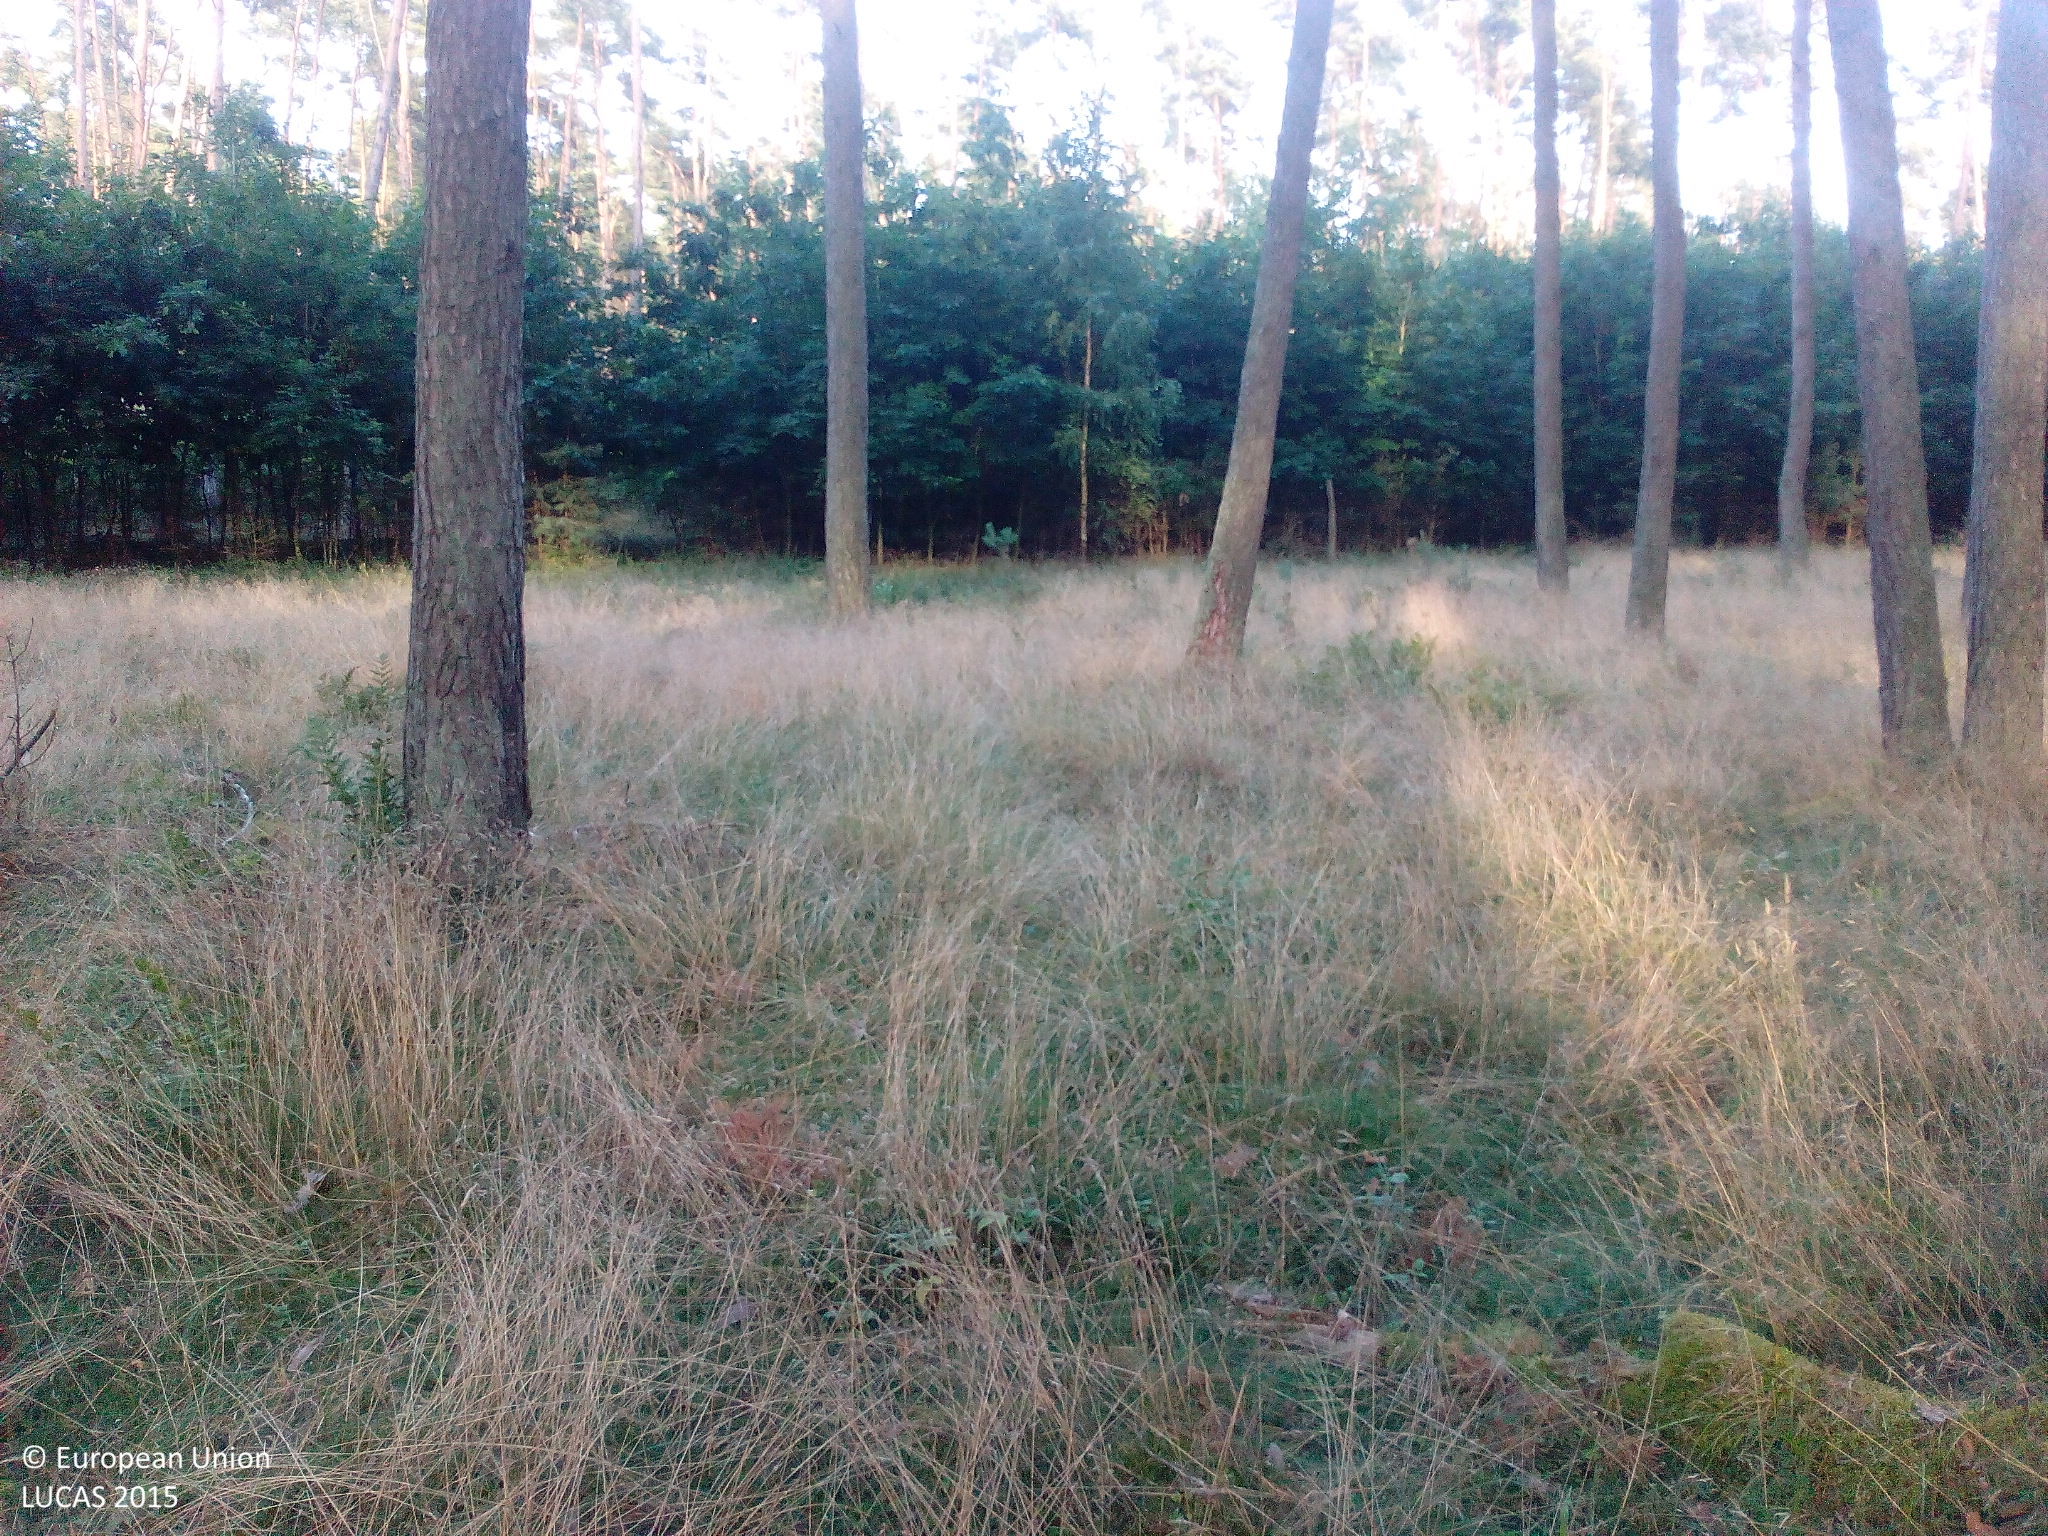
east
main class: Woodland
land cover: Pine dominated coniferous woodland
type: hemiboreal forest and nemoral coniferous forest and mixed broadleaved-coniferous forest
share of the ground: > 75 %
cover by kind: coniferous forest trees 75 %, herbaceous plants 25 %
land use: Forestry
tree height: > 5 m
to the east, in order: Pine dominated coniferous woodland; Tracks; Broadleaved woodland; Pine dominated mixed woodland; Tracks; Pine dominated mixed woodland; Grass margins; Paved roads, cycling and walking lanes; Grass margins; Pine dominated mixed woodland
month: August
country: DE
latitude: 53.5586
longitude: 12.3694
